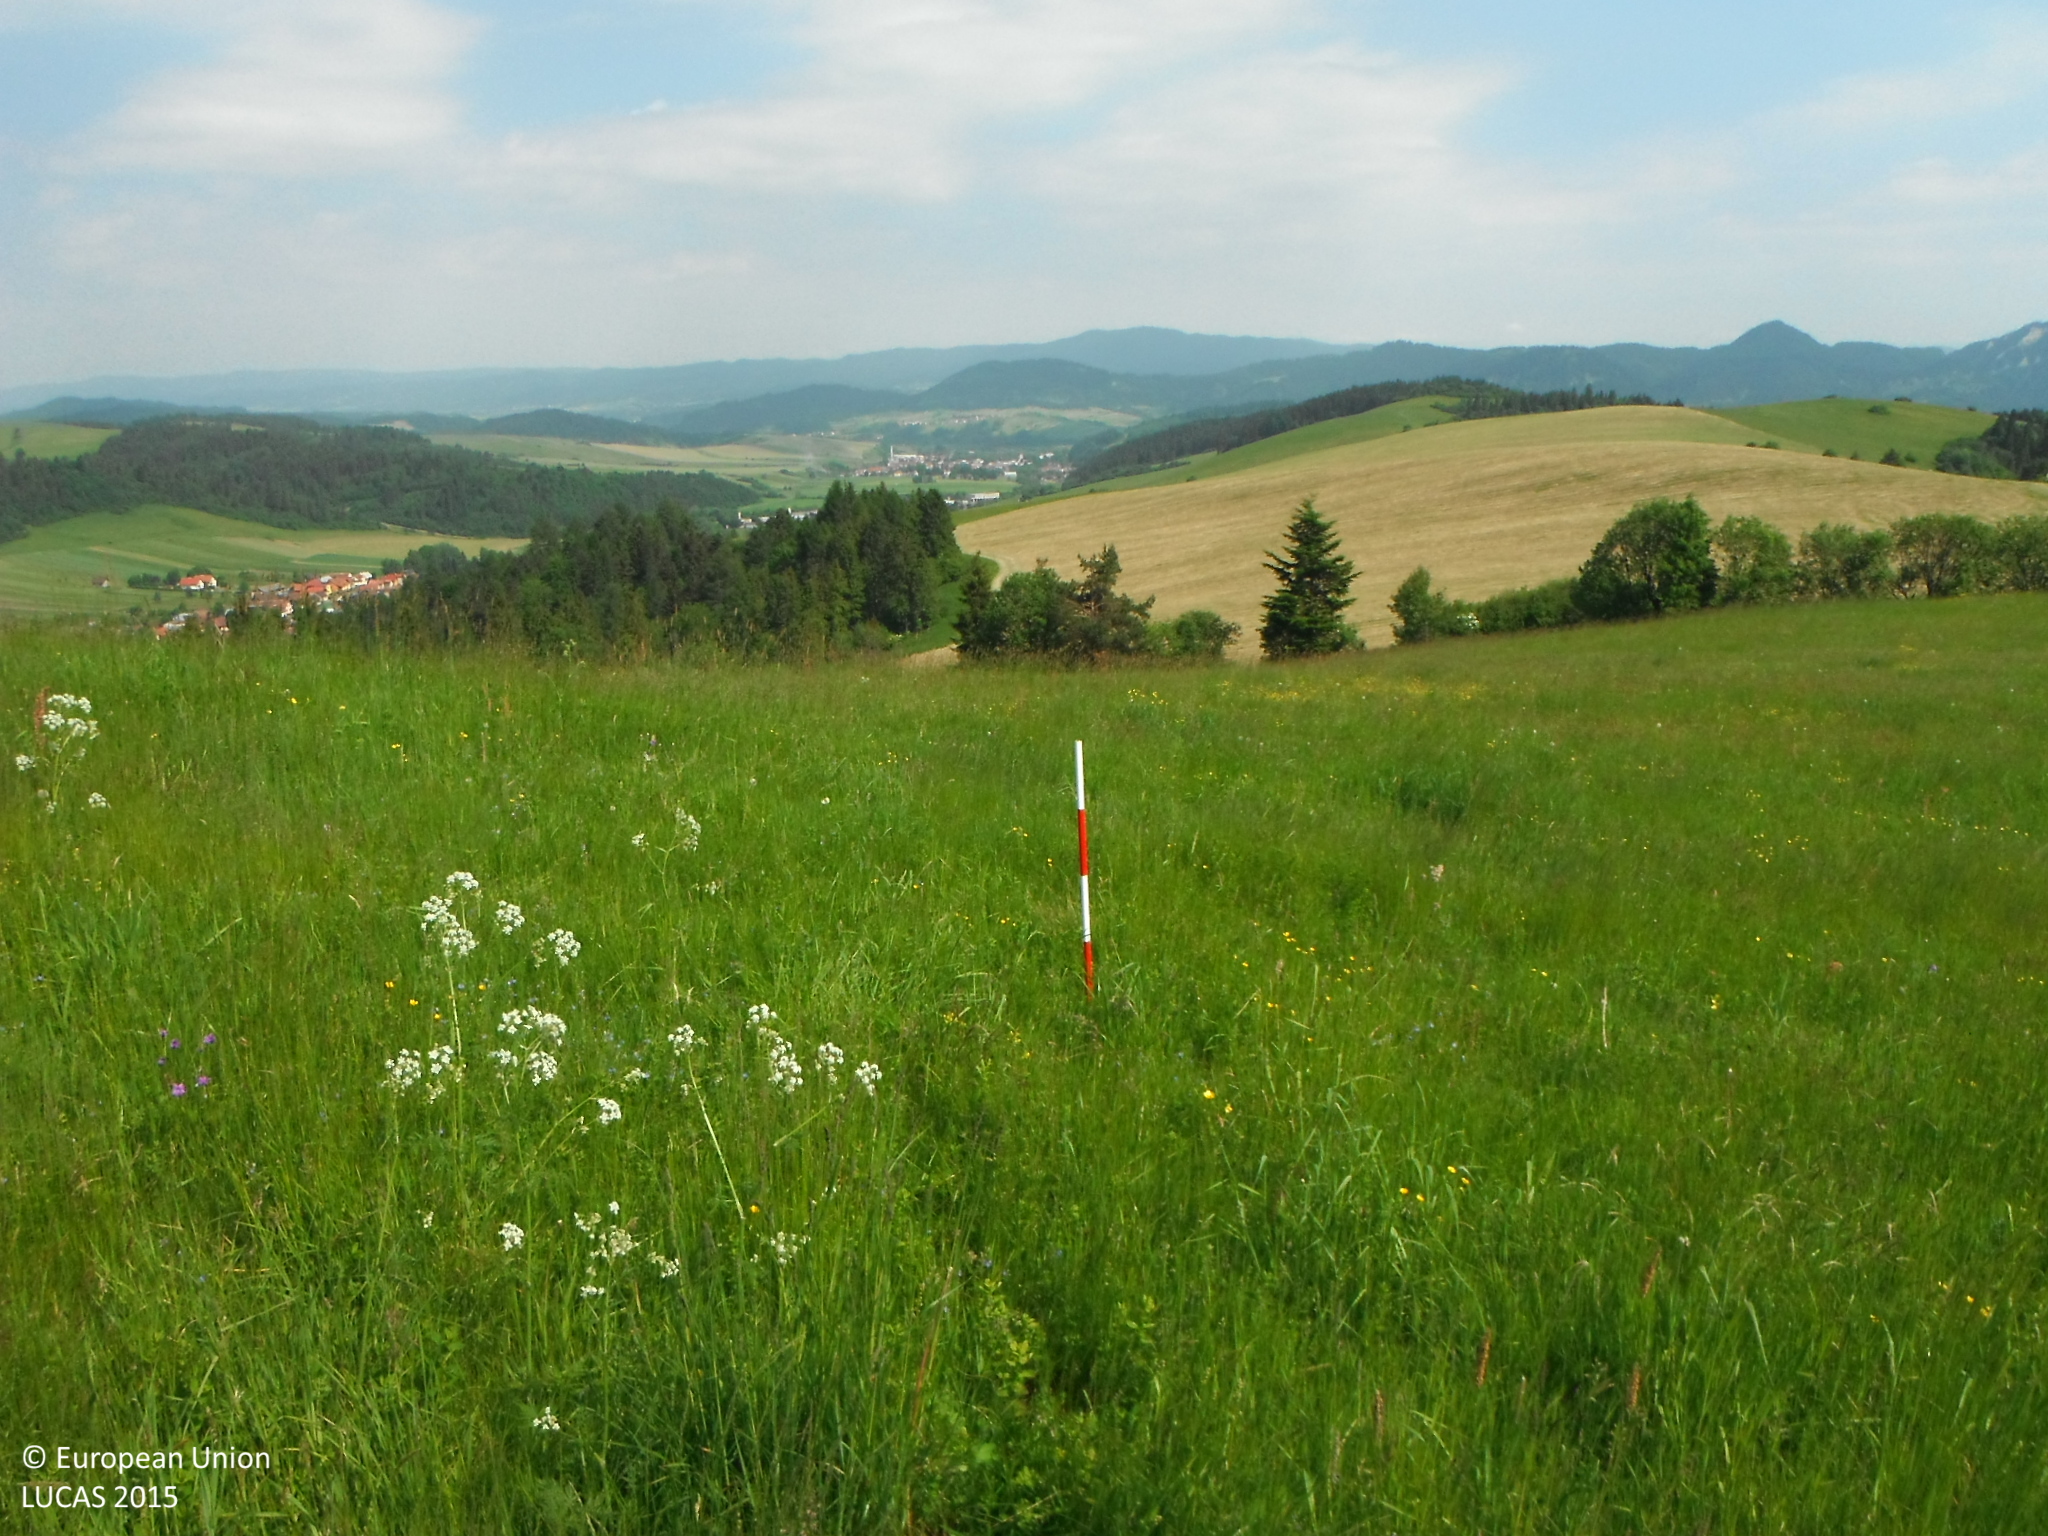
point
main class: Grassland
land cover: Grassland without tree/shrub cover
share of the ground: > 75 %
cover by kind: herbaceous plants 100 %
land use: Agriculture (excluding fallow land and kitchen gardens)
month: June
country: SK
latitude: 49.3471
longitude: 20.3728
